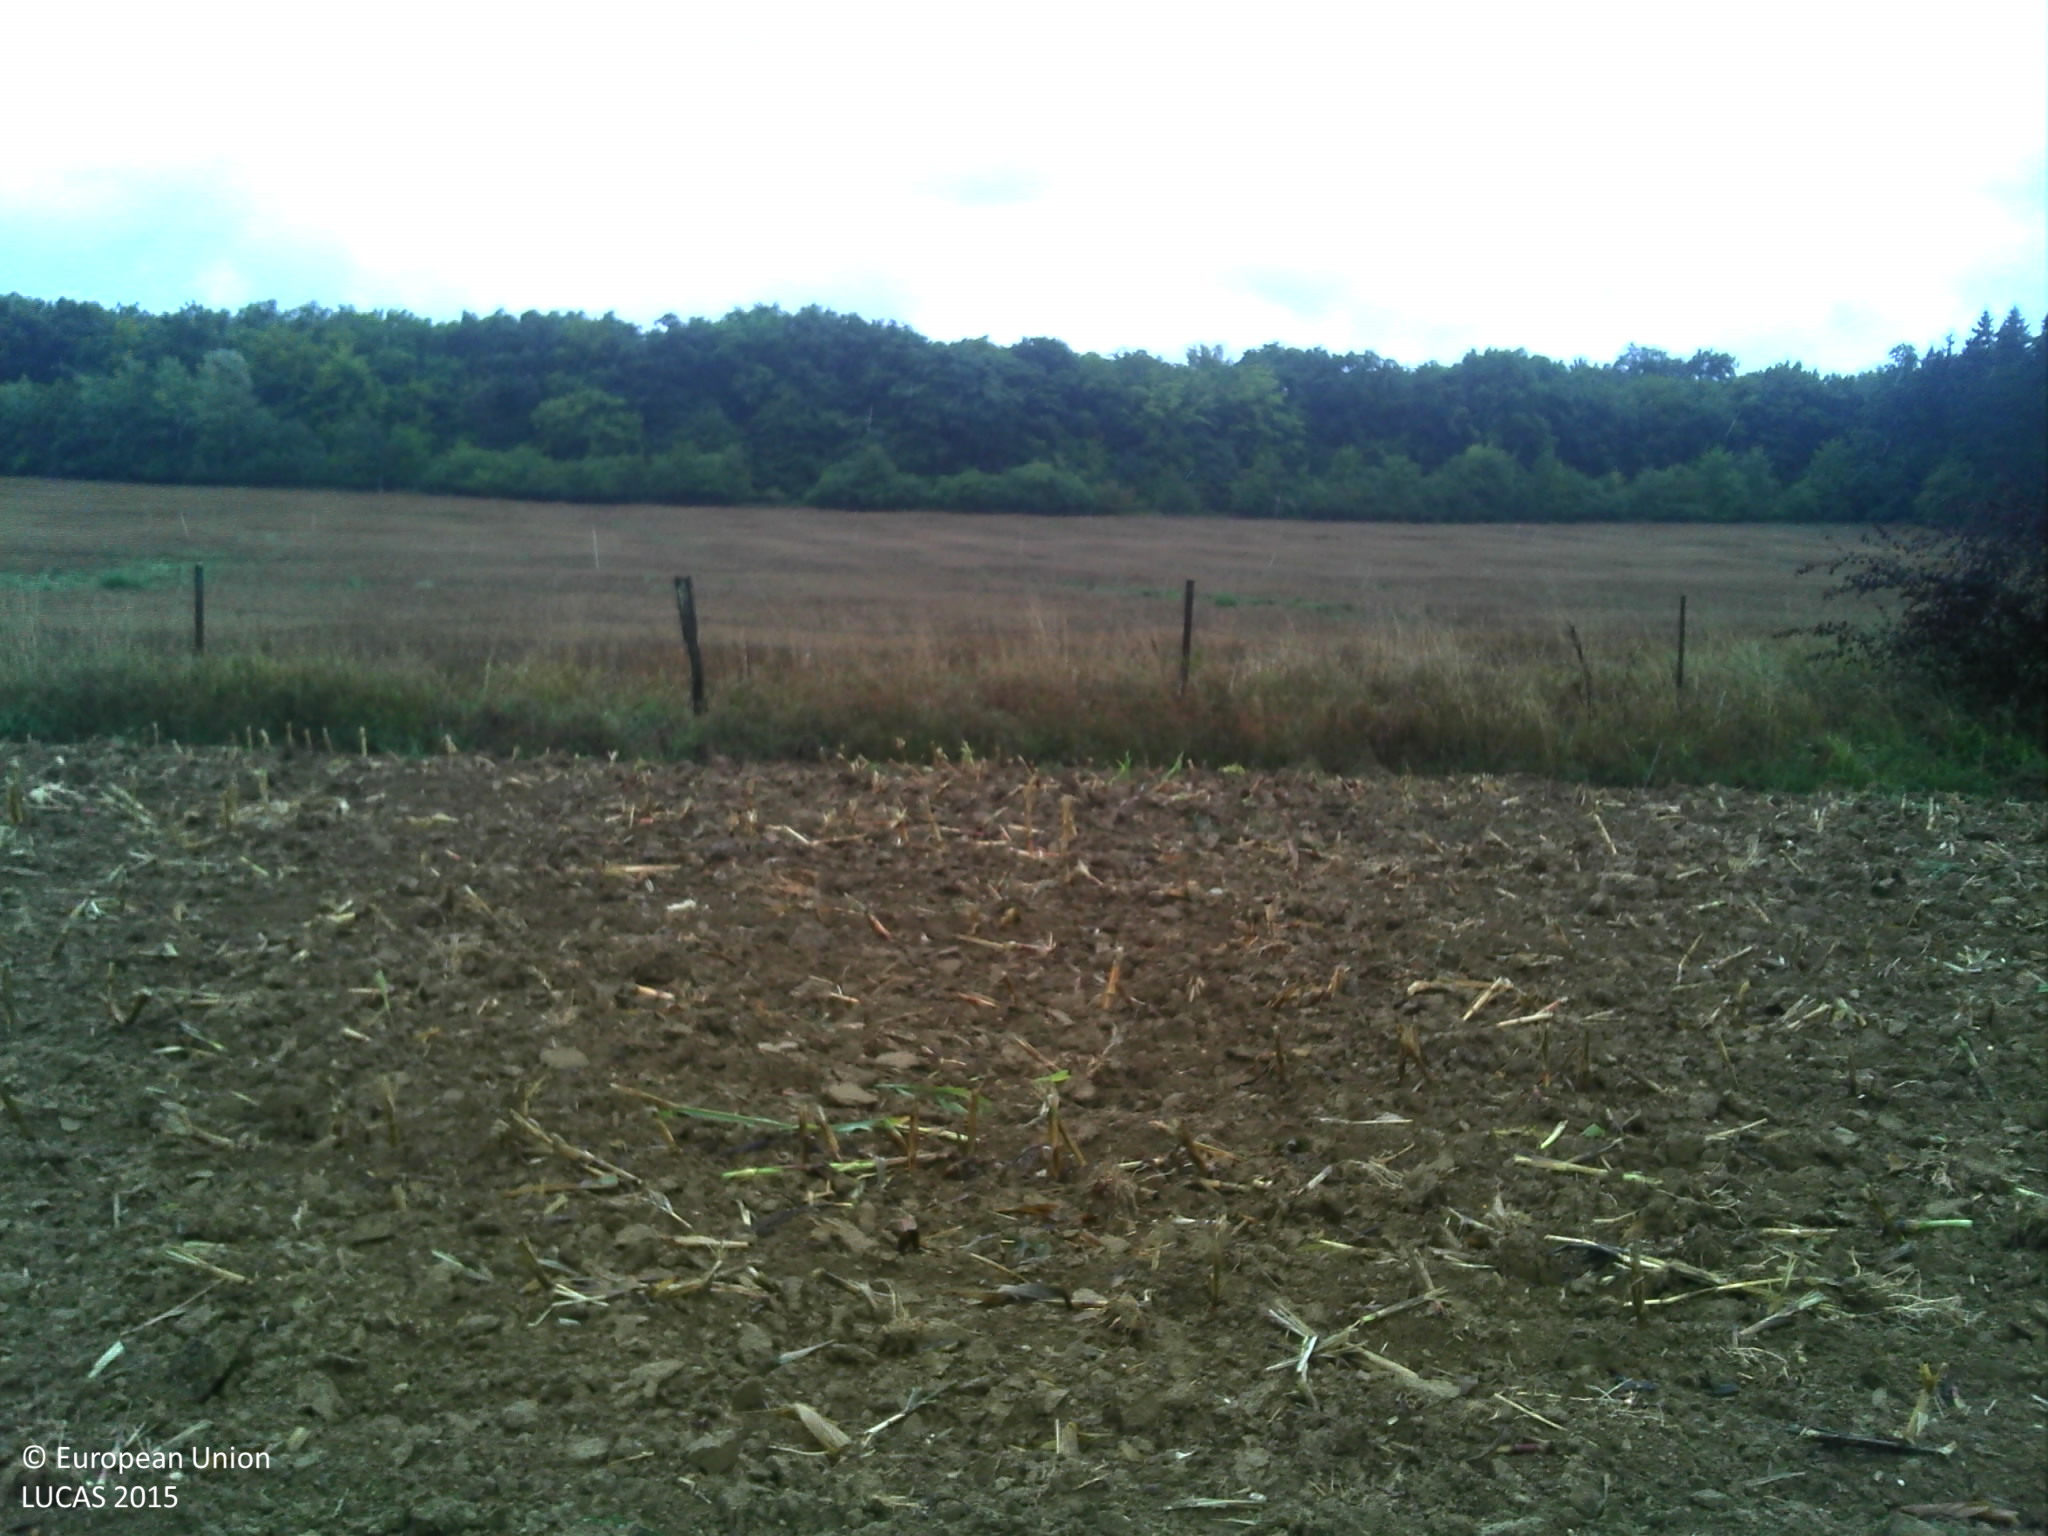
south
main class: Cropland
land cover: Maize
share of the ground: < 10 %
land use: Agriculture (excluding fallow land and kitchen gardens)
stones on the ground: < 10 %
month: September
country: FR
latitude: 49.2269
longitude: 5.8661
